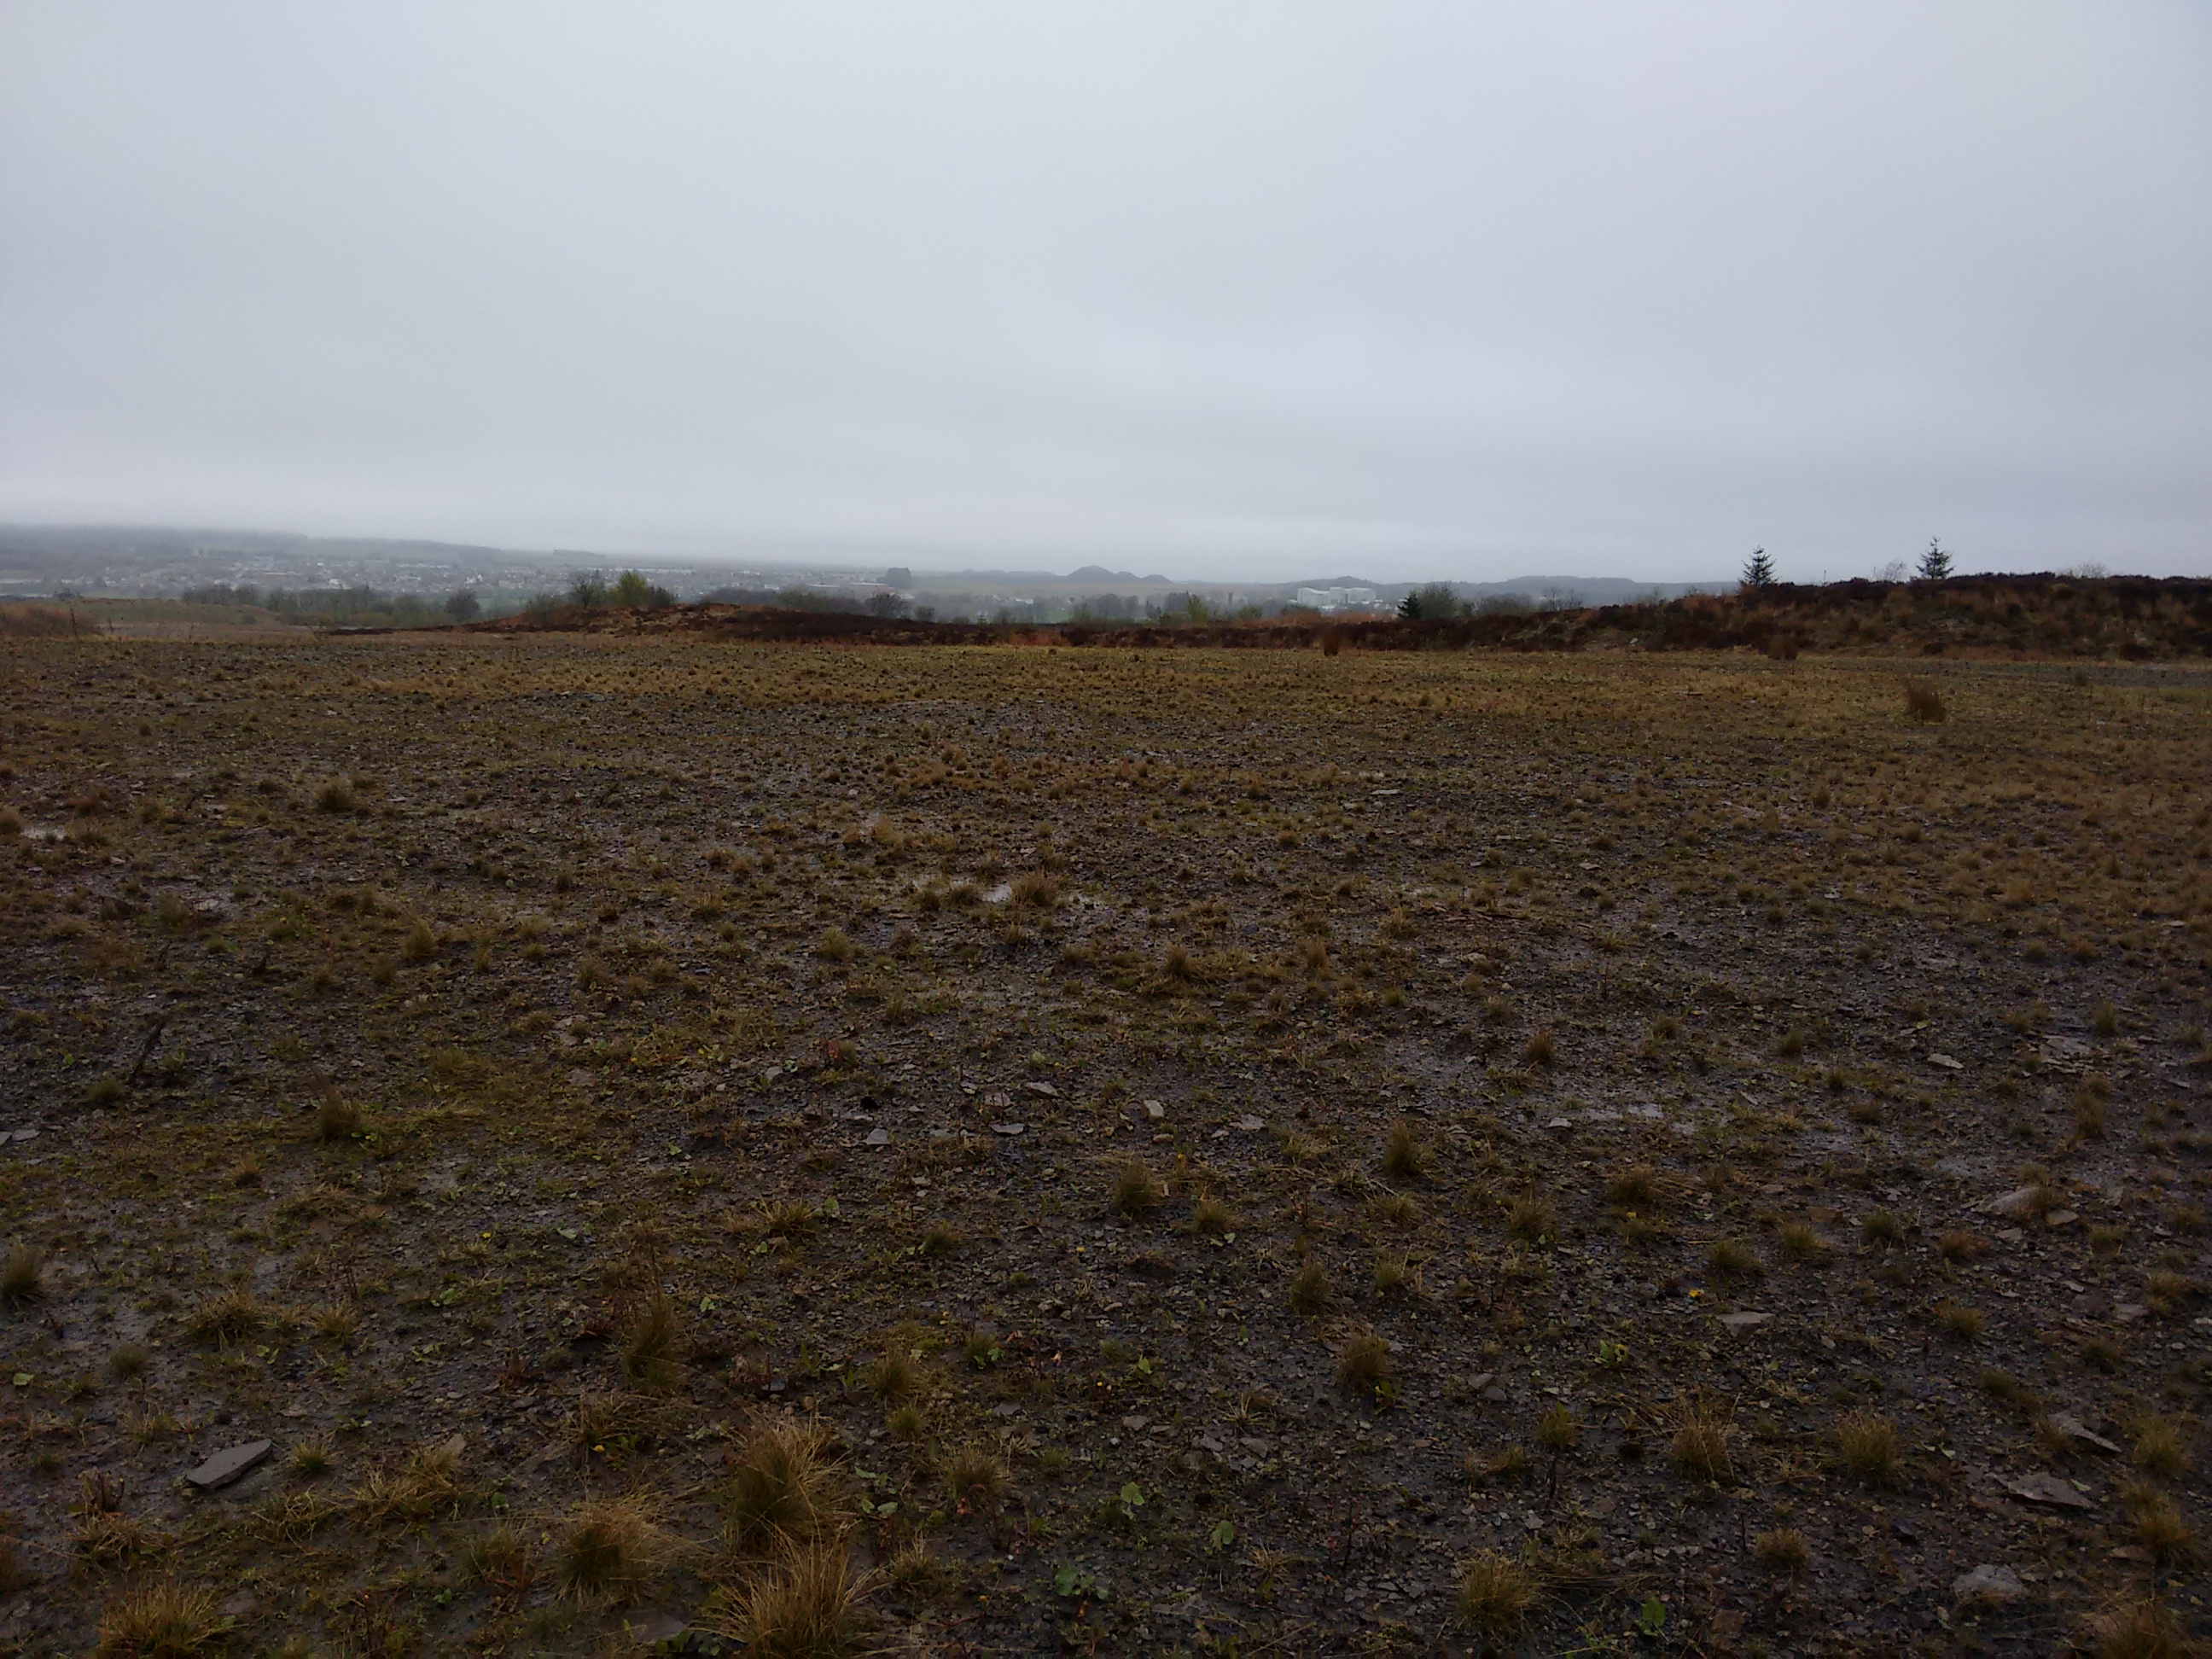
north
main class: Grassland
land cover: Spontaneously vegetated surfaces
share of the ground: > 75 %
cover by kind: herbaceous plants 50 %, unconsolidated bare surface 50 %
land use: Abandoned areas
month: May
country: GB
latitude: 55.8040
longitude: -3.7881
